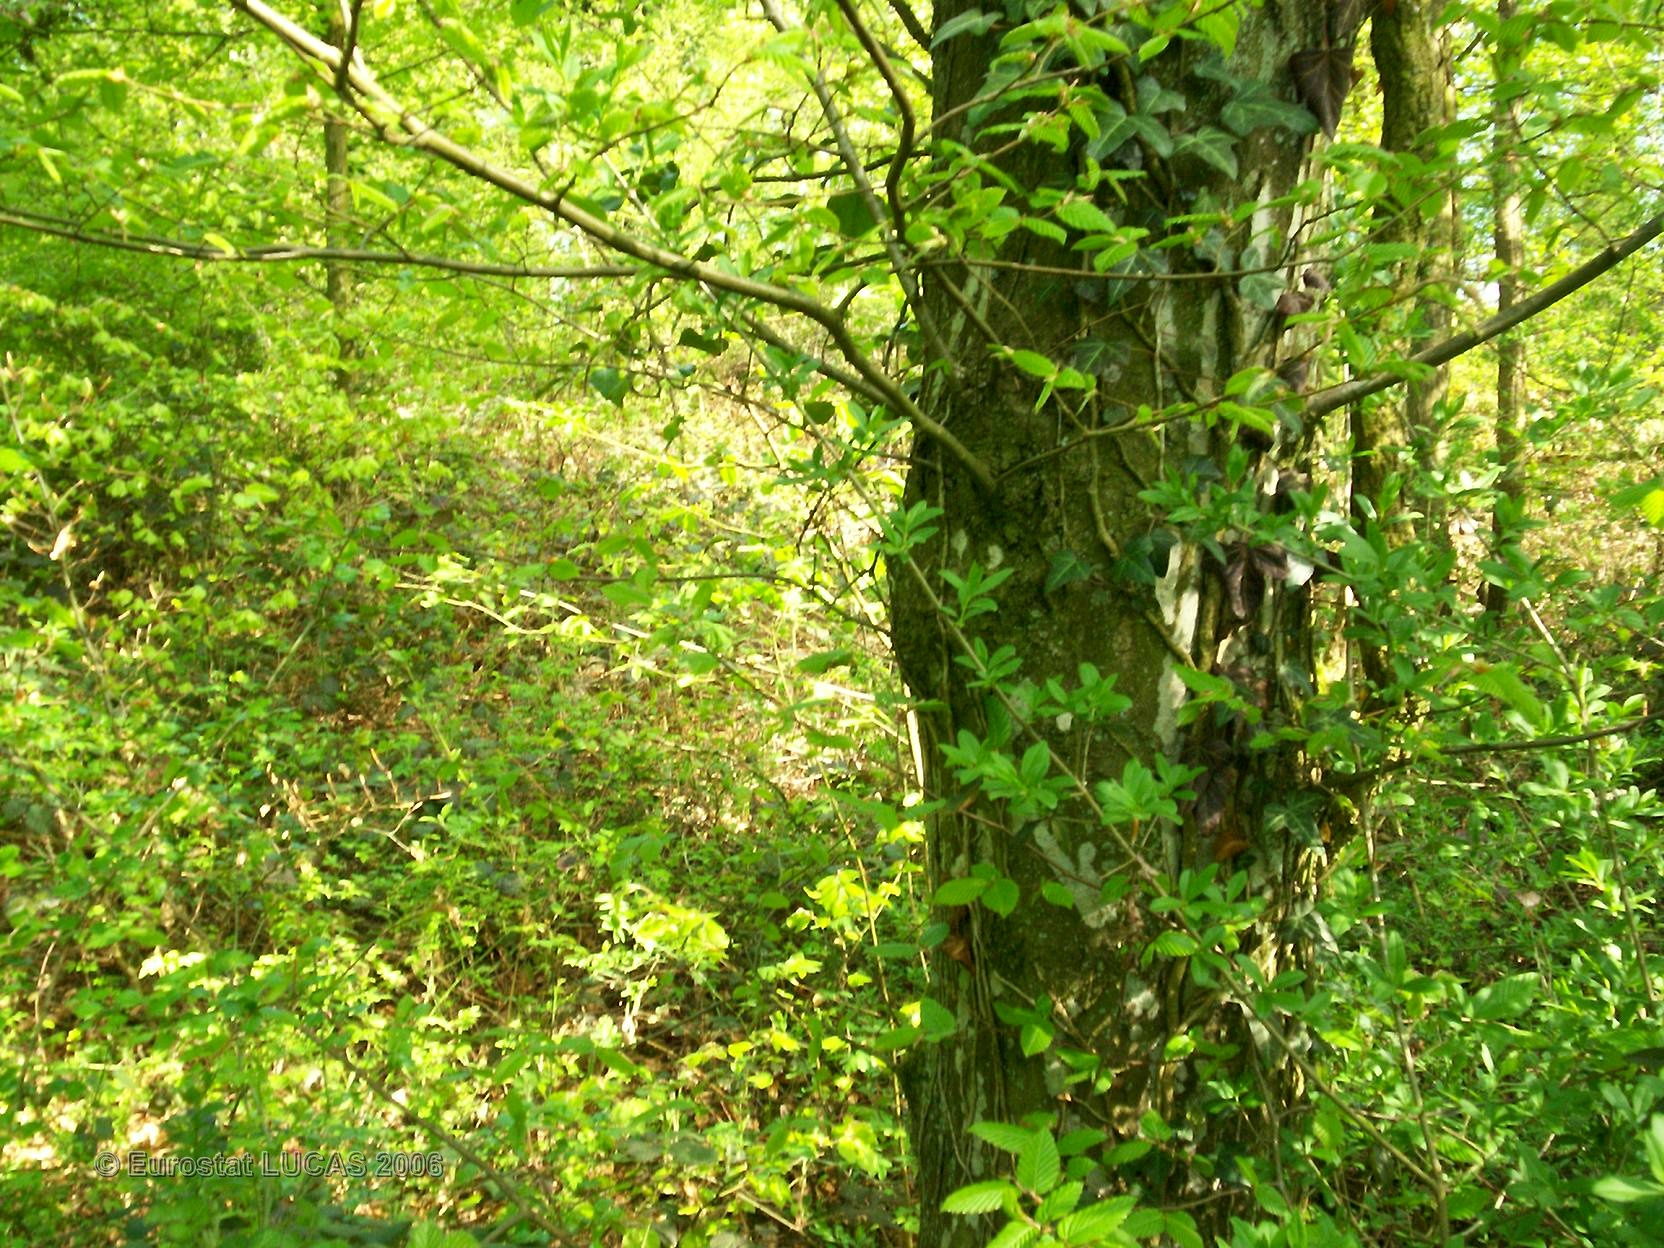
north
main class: Woodland
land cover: Broadleaved forest
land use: Forestry
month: April
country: FR
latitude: 49.0230
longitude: 6.7866
